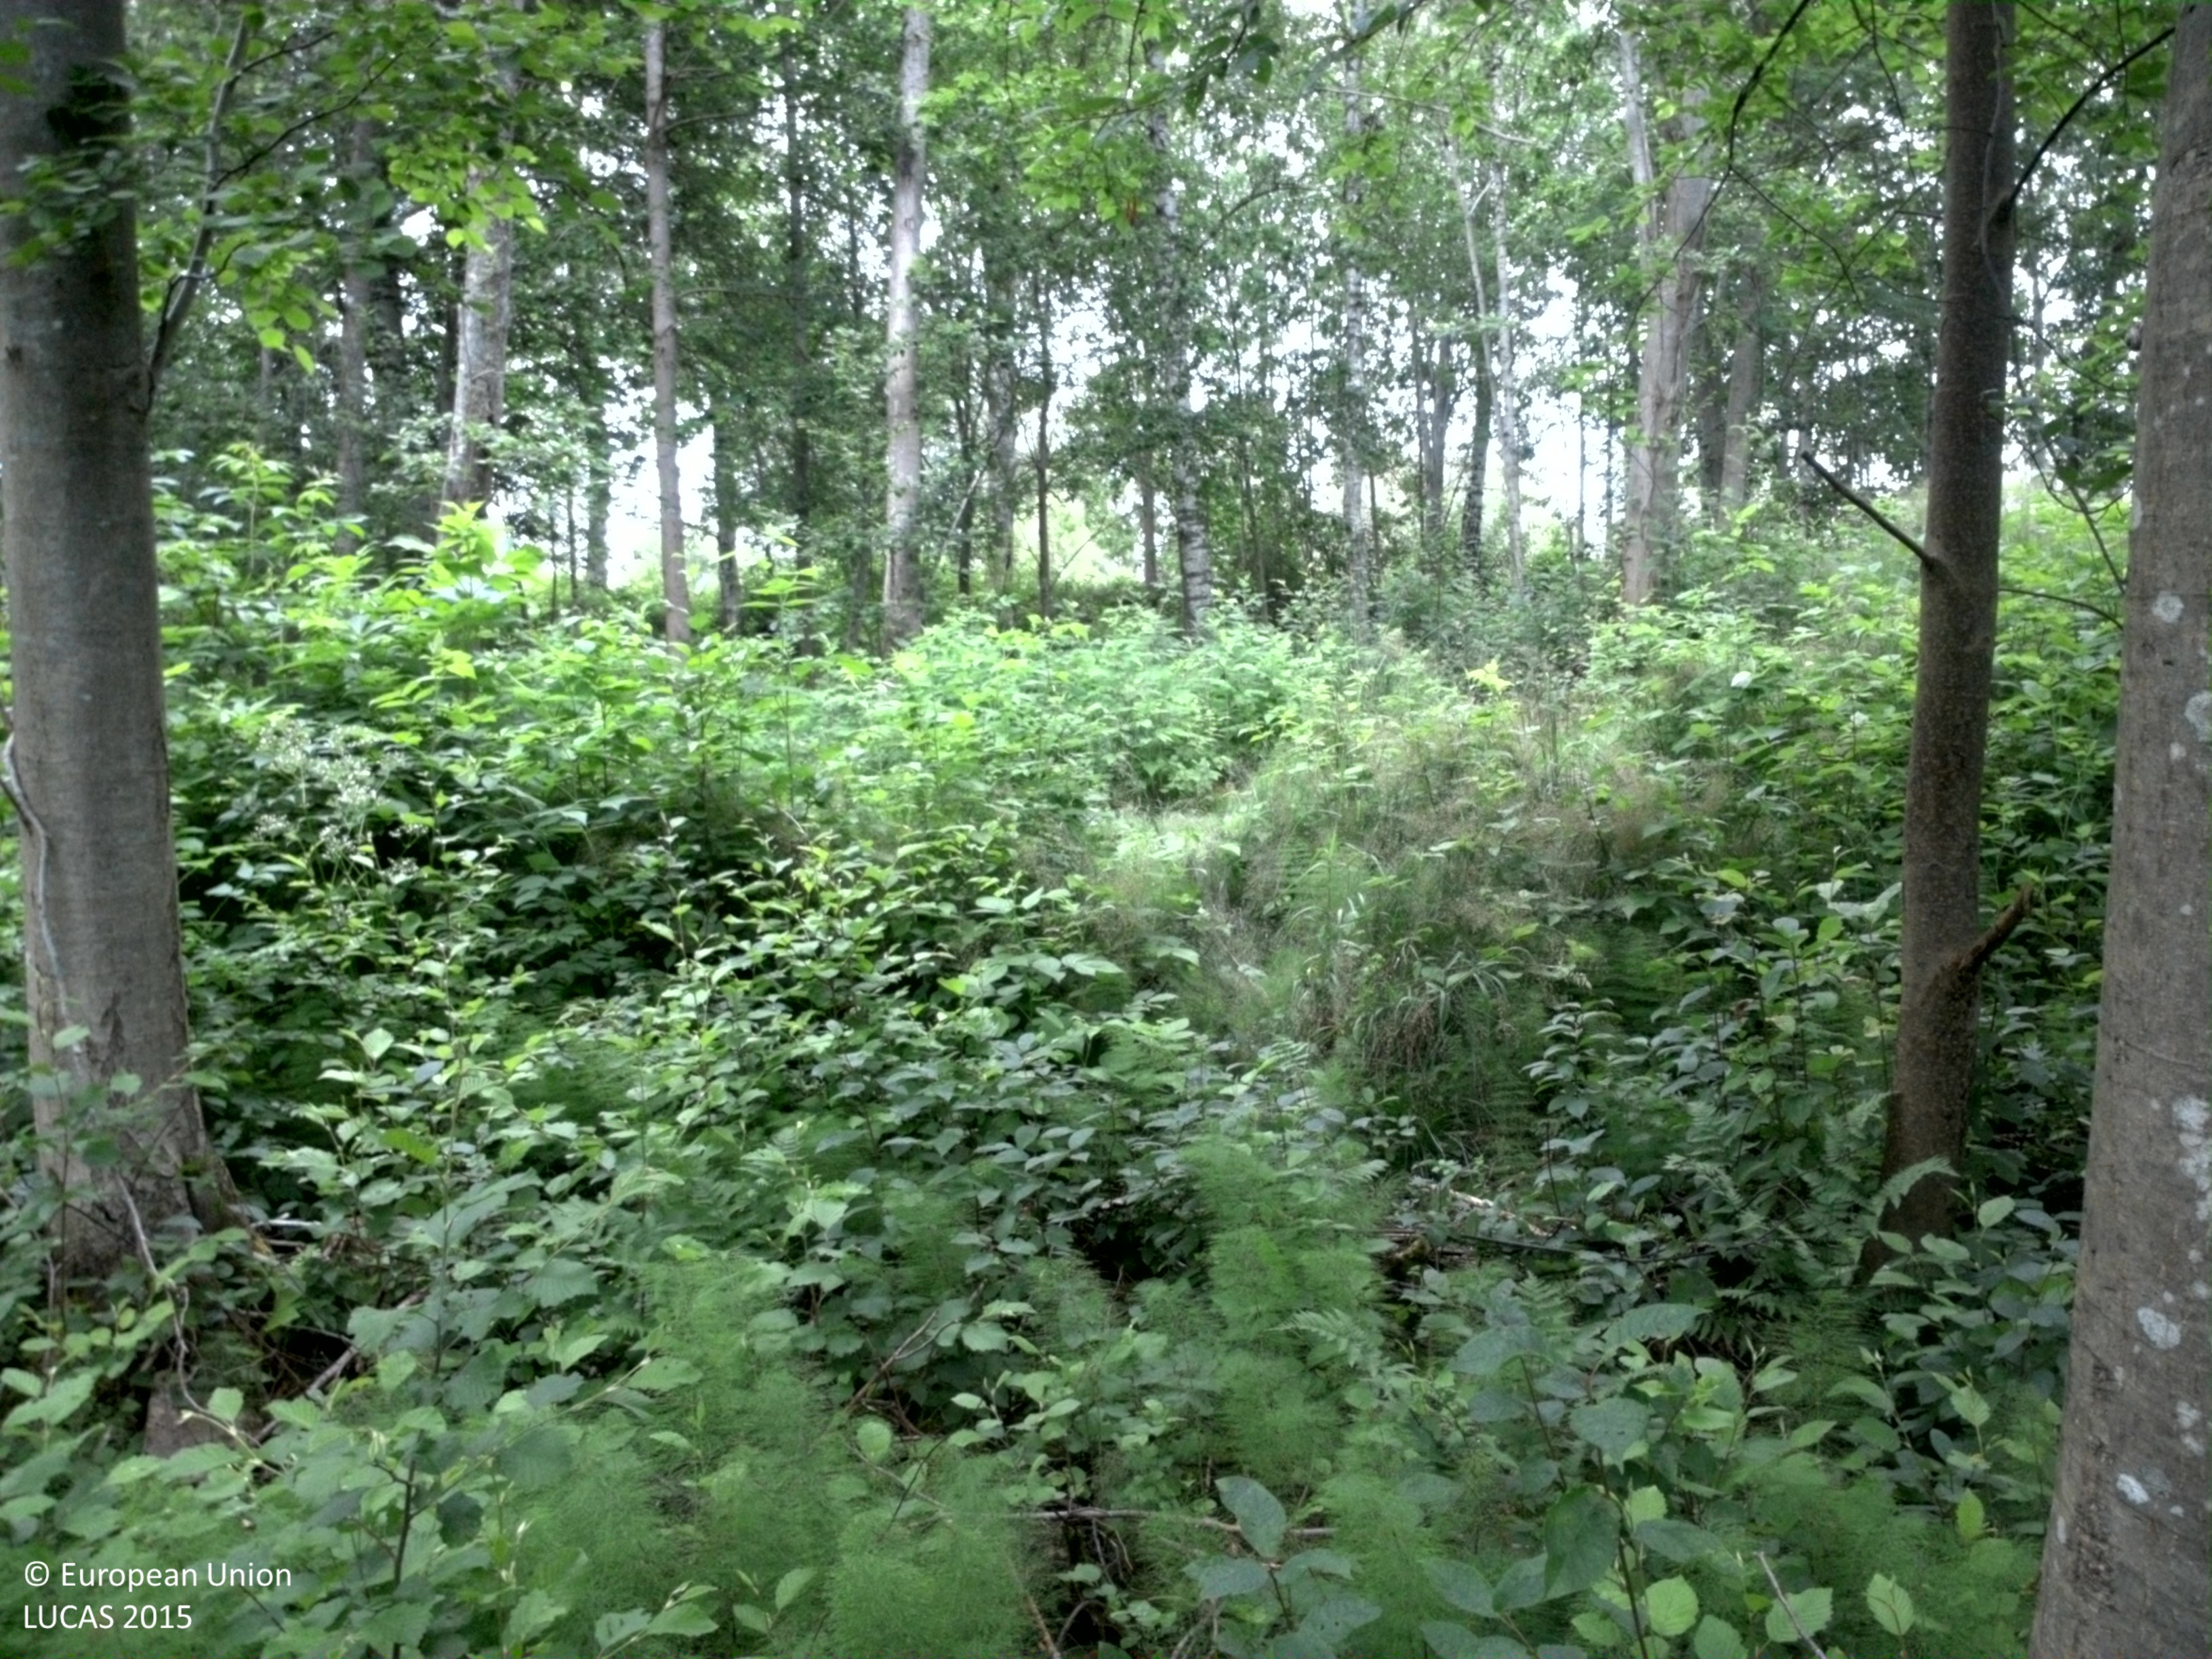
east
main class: Woodland
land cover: Broadleaved woodland
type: boreal forest
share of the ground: 50 - 75 %
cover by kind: broadleaved forest trees 60 %, shrubs 30 %, herbaceous plants 10 %
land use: Forestry
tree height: > 5 m
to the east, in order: Broadleaved woodland; Shrubland with sparse tree cover; Broadleaved woodland; Tracks; Broadleaved woodland; Grassland with sparse tree/shrub cover; Tracks; Grassland without tree/shrub cover; Tracks; Broadleaved woodland; Grassland with sparse tree/shrub cover; Artificial constructions in urban areas
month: July
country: SE
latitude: 59.3904
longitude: 12.1250
